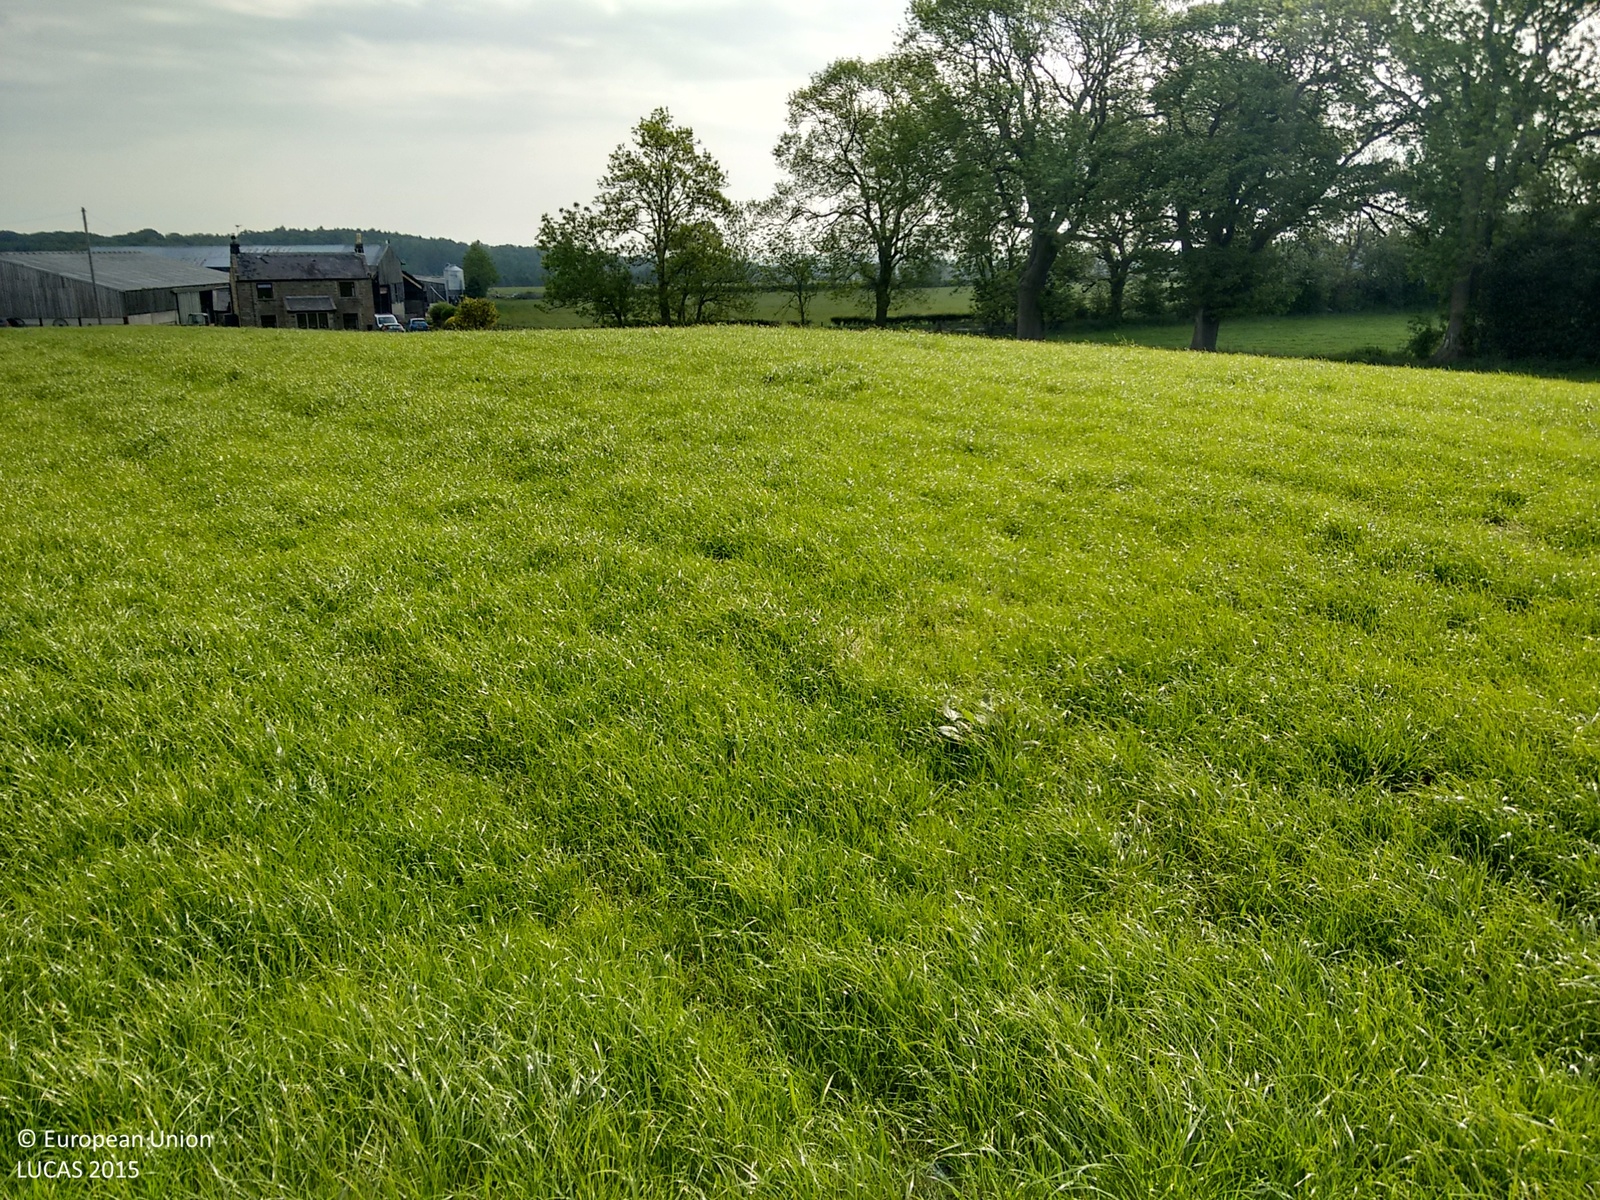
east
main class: Cropland
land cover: Temporary grasslands
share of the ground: > 75 %
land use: Agriculture (excluding fallow land and kitchen gardens)
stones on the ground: < 10 %
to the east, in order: Temporary grasslands; Lines of trees; Temporary grasslands; Lines of trees; Grass margins; Paved roads, cycling and walking lanes; Grass margins; Managed hedges; Fences; Grassland without tree/shrub cover
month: June
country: GB
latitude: 54.0612
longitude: -1.5854
